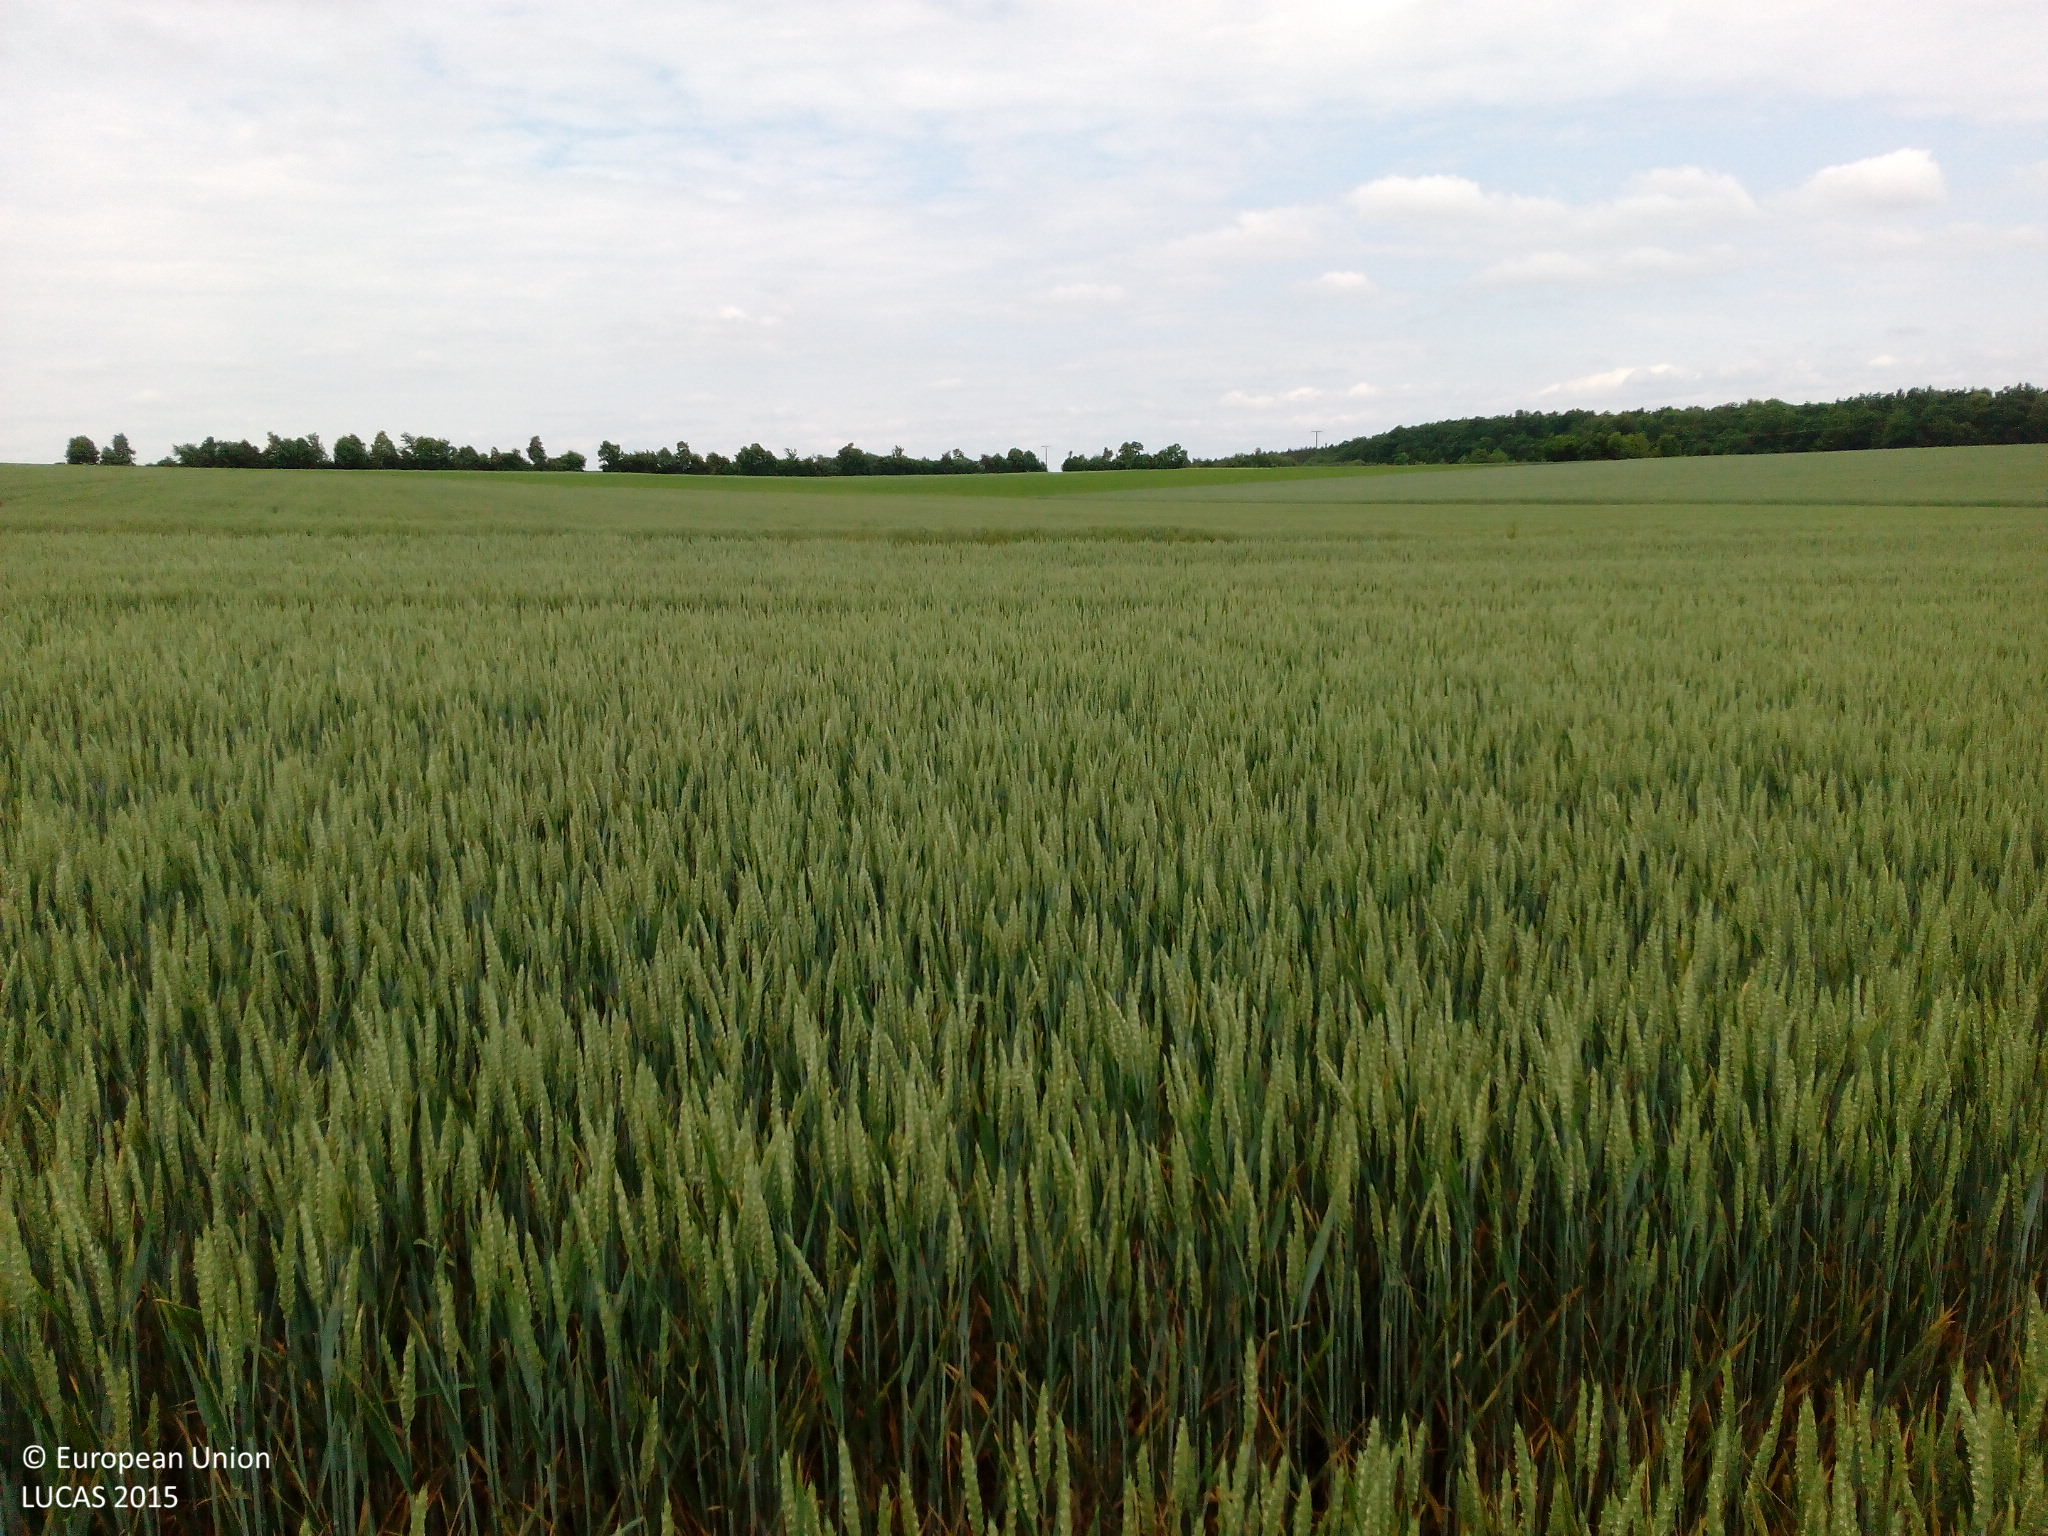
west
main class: Cropland
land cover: Common wheat
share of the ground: > 75 %
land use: Agriculture (excluding fallow land and kitchen gardens)
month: June
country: DE
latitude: 50.2556
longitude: 10.3505
